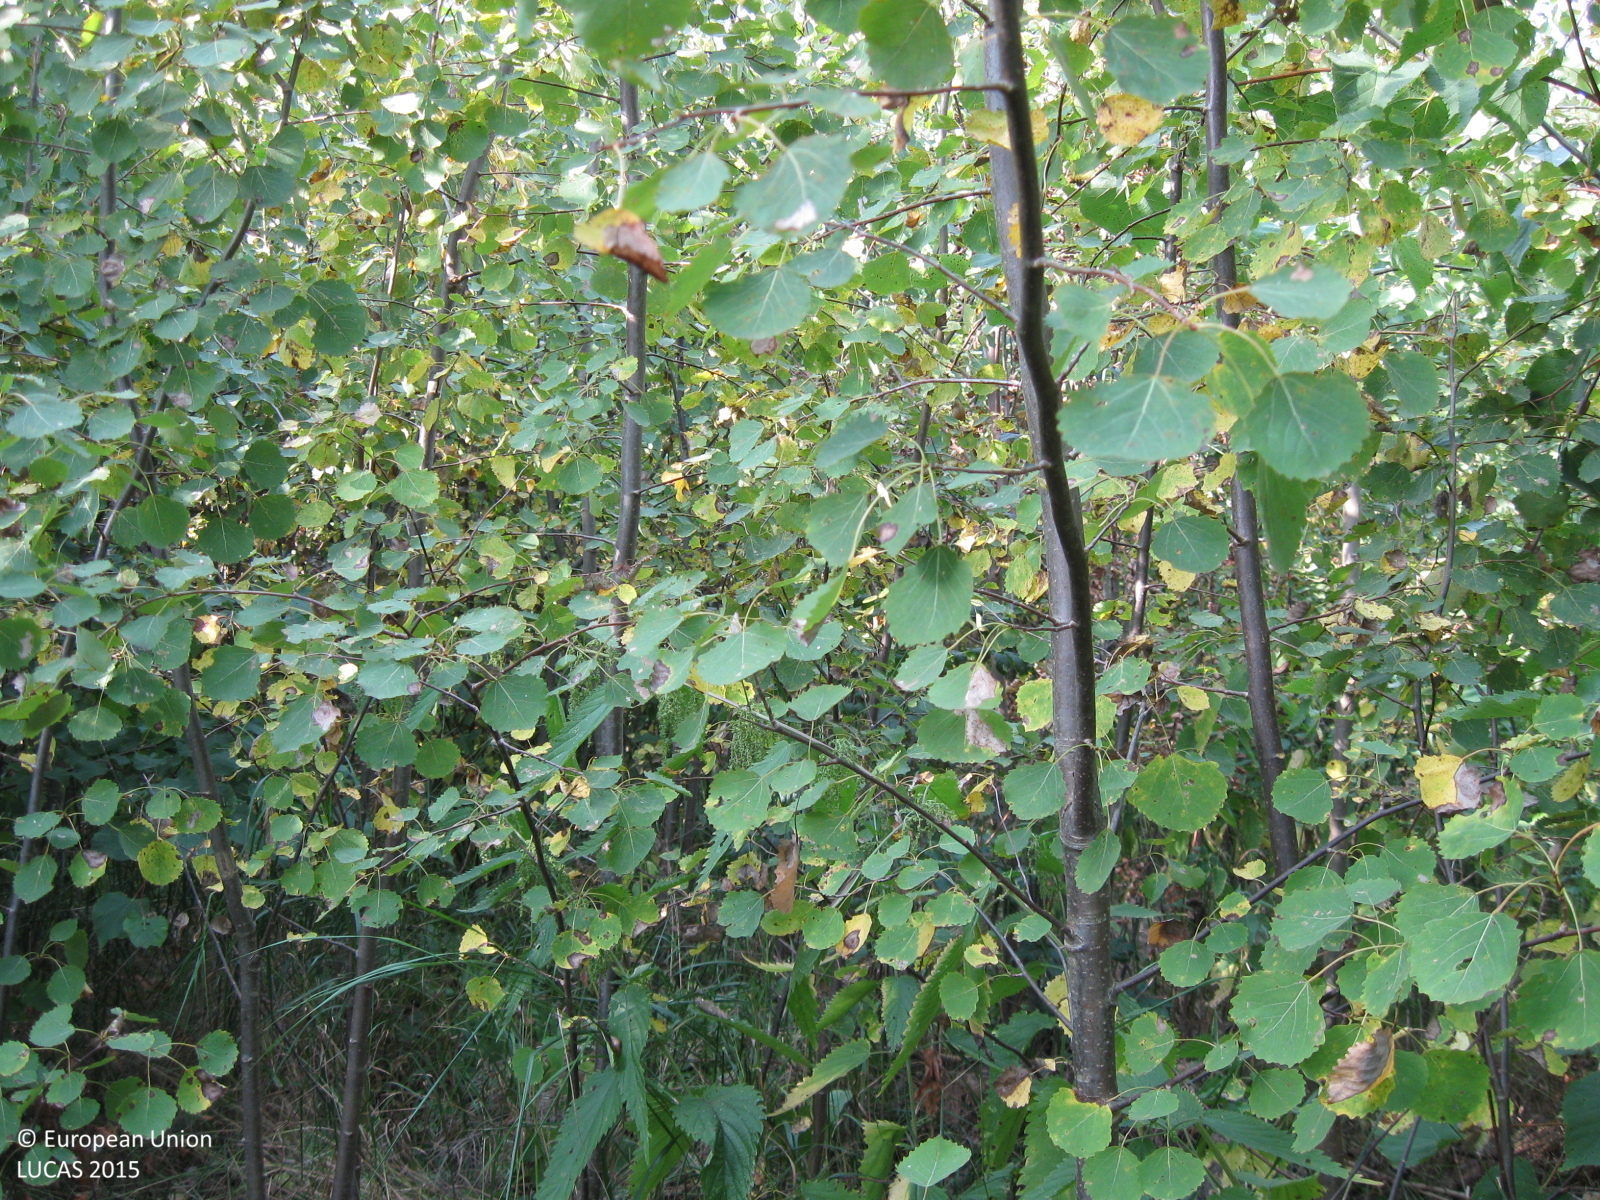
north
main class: Woodland
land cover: Broadleaved woodland
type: non-riverine alder, birch or aspen forest
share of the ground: > 75 %
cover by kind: broadleaved forest trees 80 %, herbaceous plants 20 %
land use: Forestry
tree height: < 5 m
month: August
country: LT
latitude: 55.5987
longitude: 22.9715
